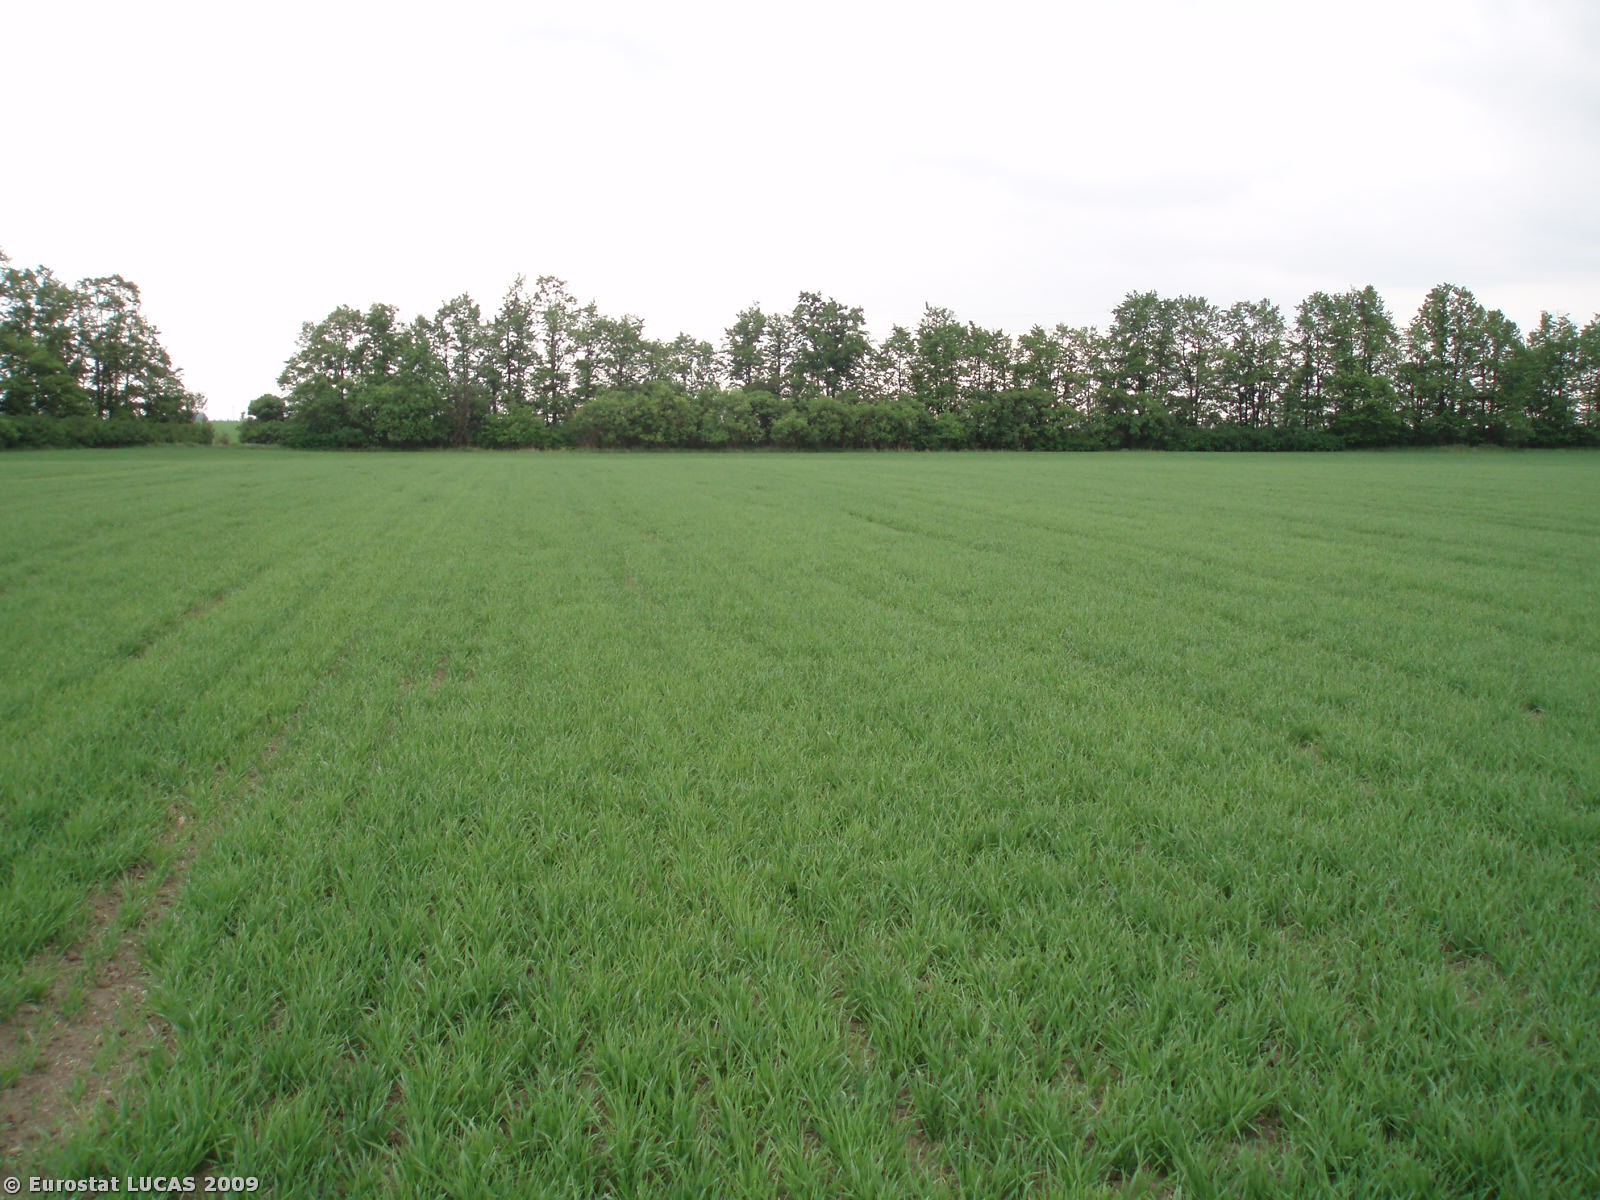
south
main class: Cropland
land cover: Barley
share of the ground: > 75 %
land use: Agriculture (excluding fallow land and kitchen gardens)
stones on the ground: < 10 %
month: May
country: CZ
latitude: 50.1445
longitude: 14.1571
